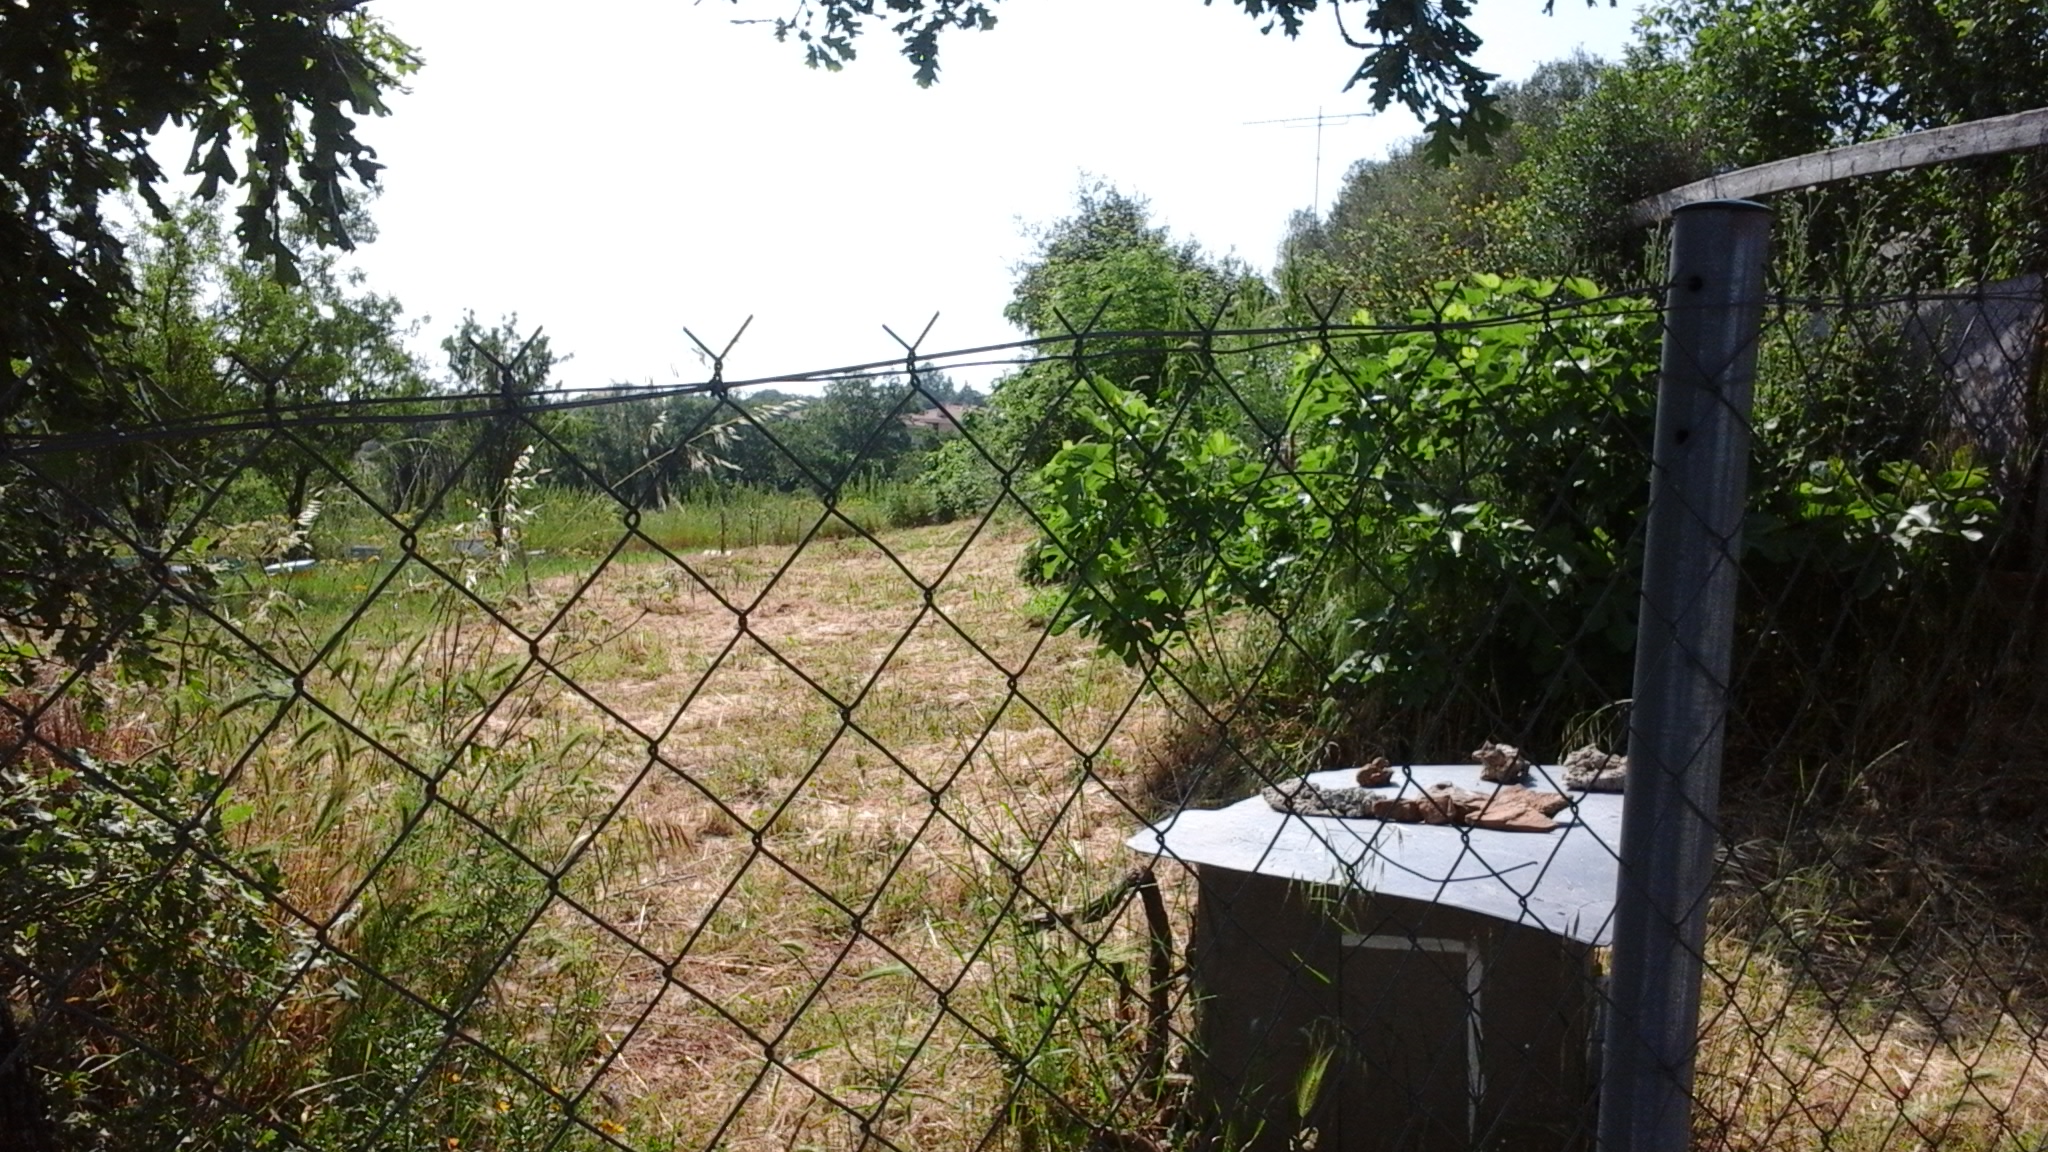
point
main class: Cropland
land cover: Nuts trees
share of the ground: 50 - 75 %
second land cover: Spontaneously vegetated surfaces
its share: > 75 %
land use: Agriculture (excluding fallow land and kitchen gardens)
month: May
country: GR
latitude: 40.7611
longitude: 22.9323
